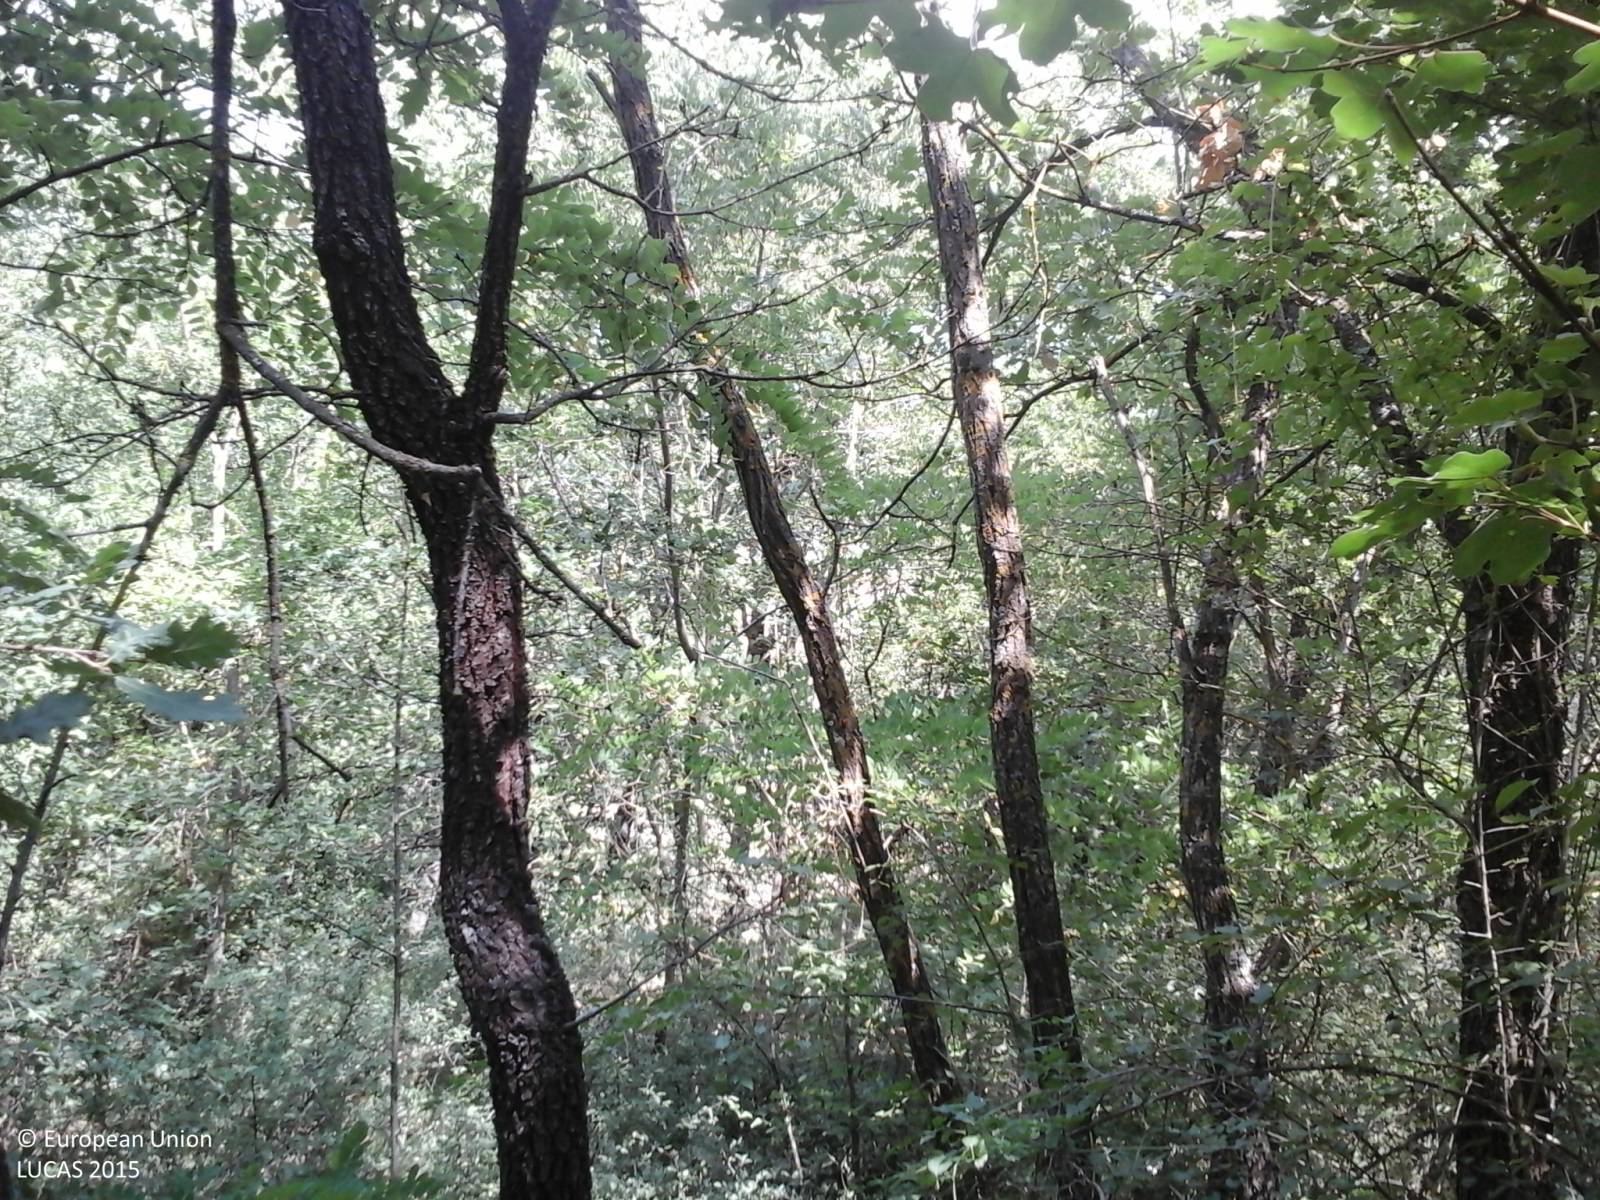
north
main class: Woodland
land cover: Broadleaved woodland
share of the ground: > 75 %
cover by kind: broadleaved forest trees 100 %
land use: Semi-natural and natural areas not in use
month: July
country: IT
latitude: 42.3258
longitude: 13.3989
